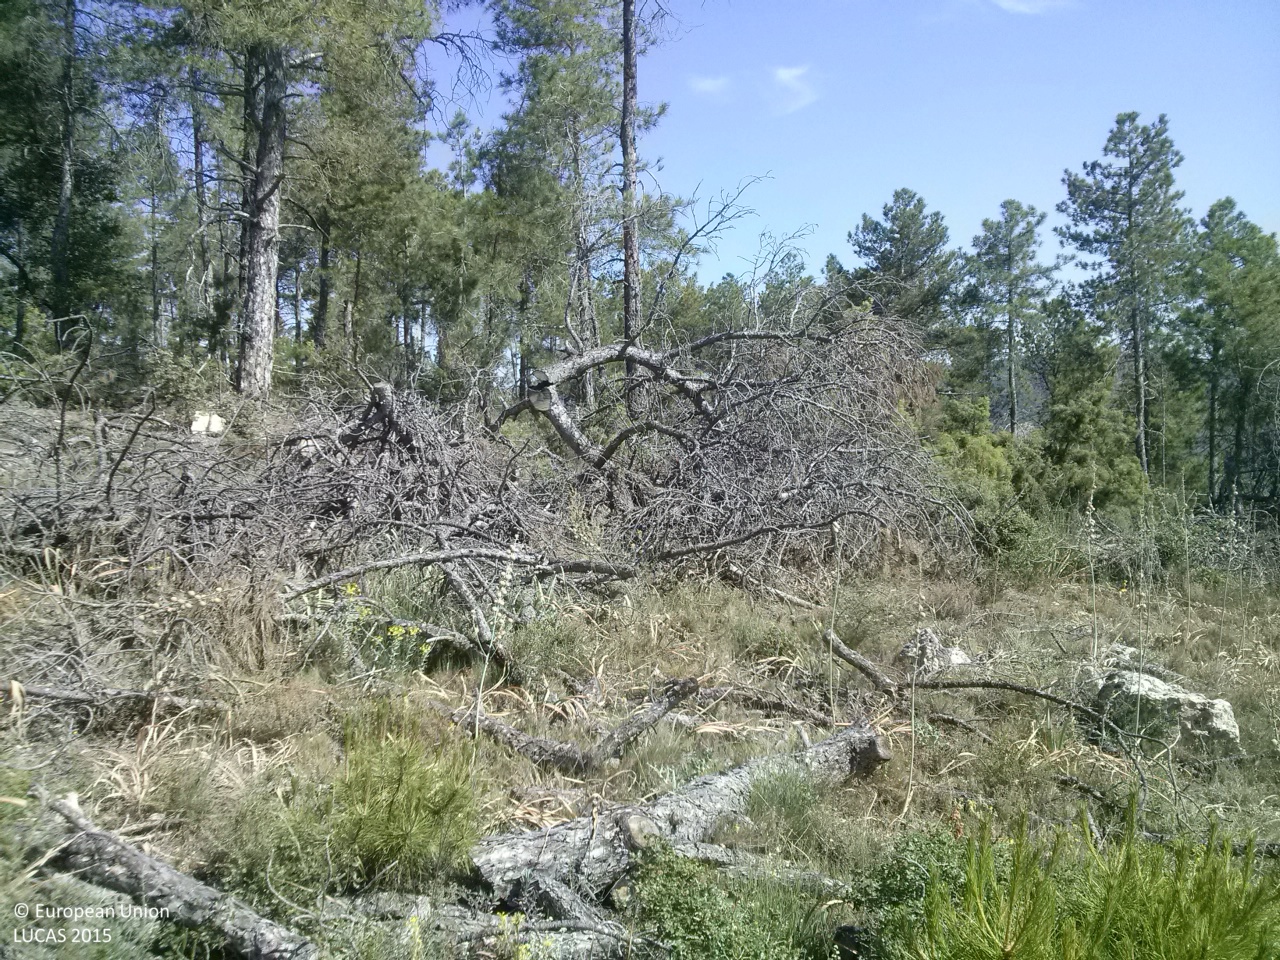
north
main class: Woodland
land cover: Pine dominated mixed woodland
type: coniferous forest of the mediterranean region
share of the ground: 10 - 25 %
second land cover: Shrubland without tree cover
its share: 25 - 50 %
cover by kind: shrubs 40 %, herbaceous plants 30 %, coniferous forest trees 20 %, broadleaved forest trees 10 %
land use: Forestry
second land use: Agriculture (excluding fallow land and kitchen gardens)
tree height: > 5 m
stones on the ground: 25 - 50 %
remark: Clear cut
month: June
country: ES
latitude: 39.9768
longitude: -1.6143
